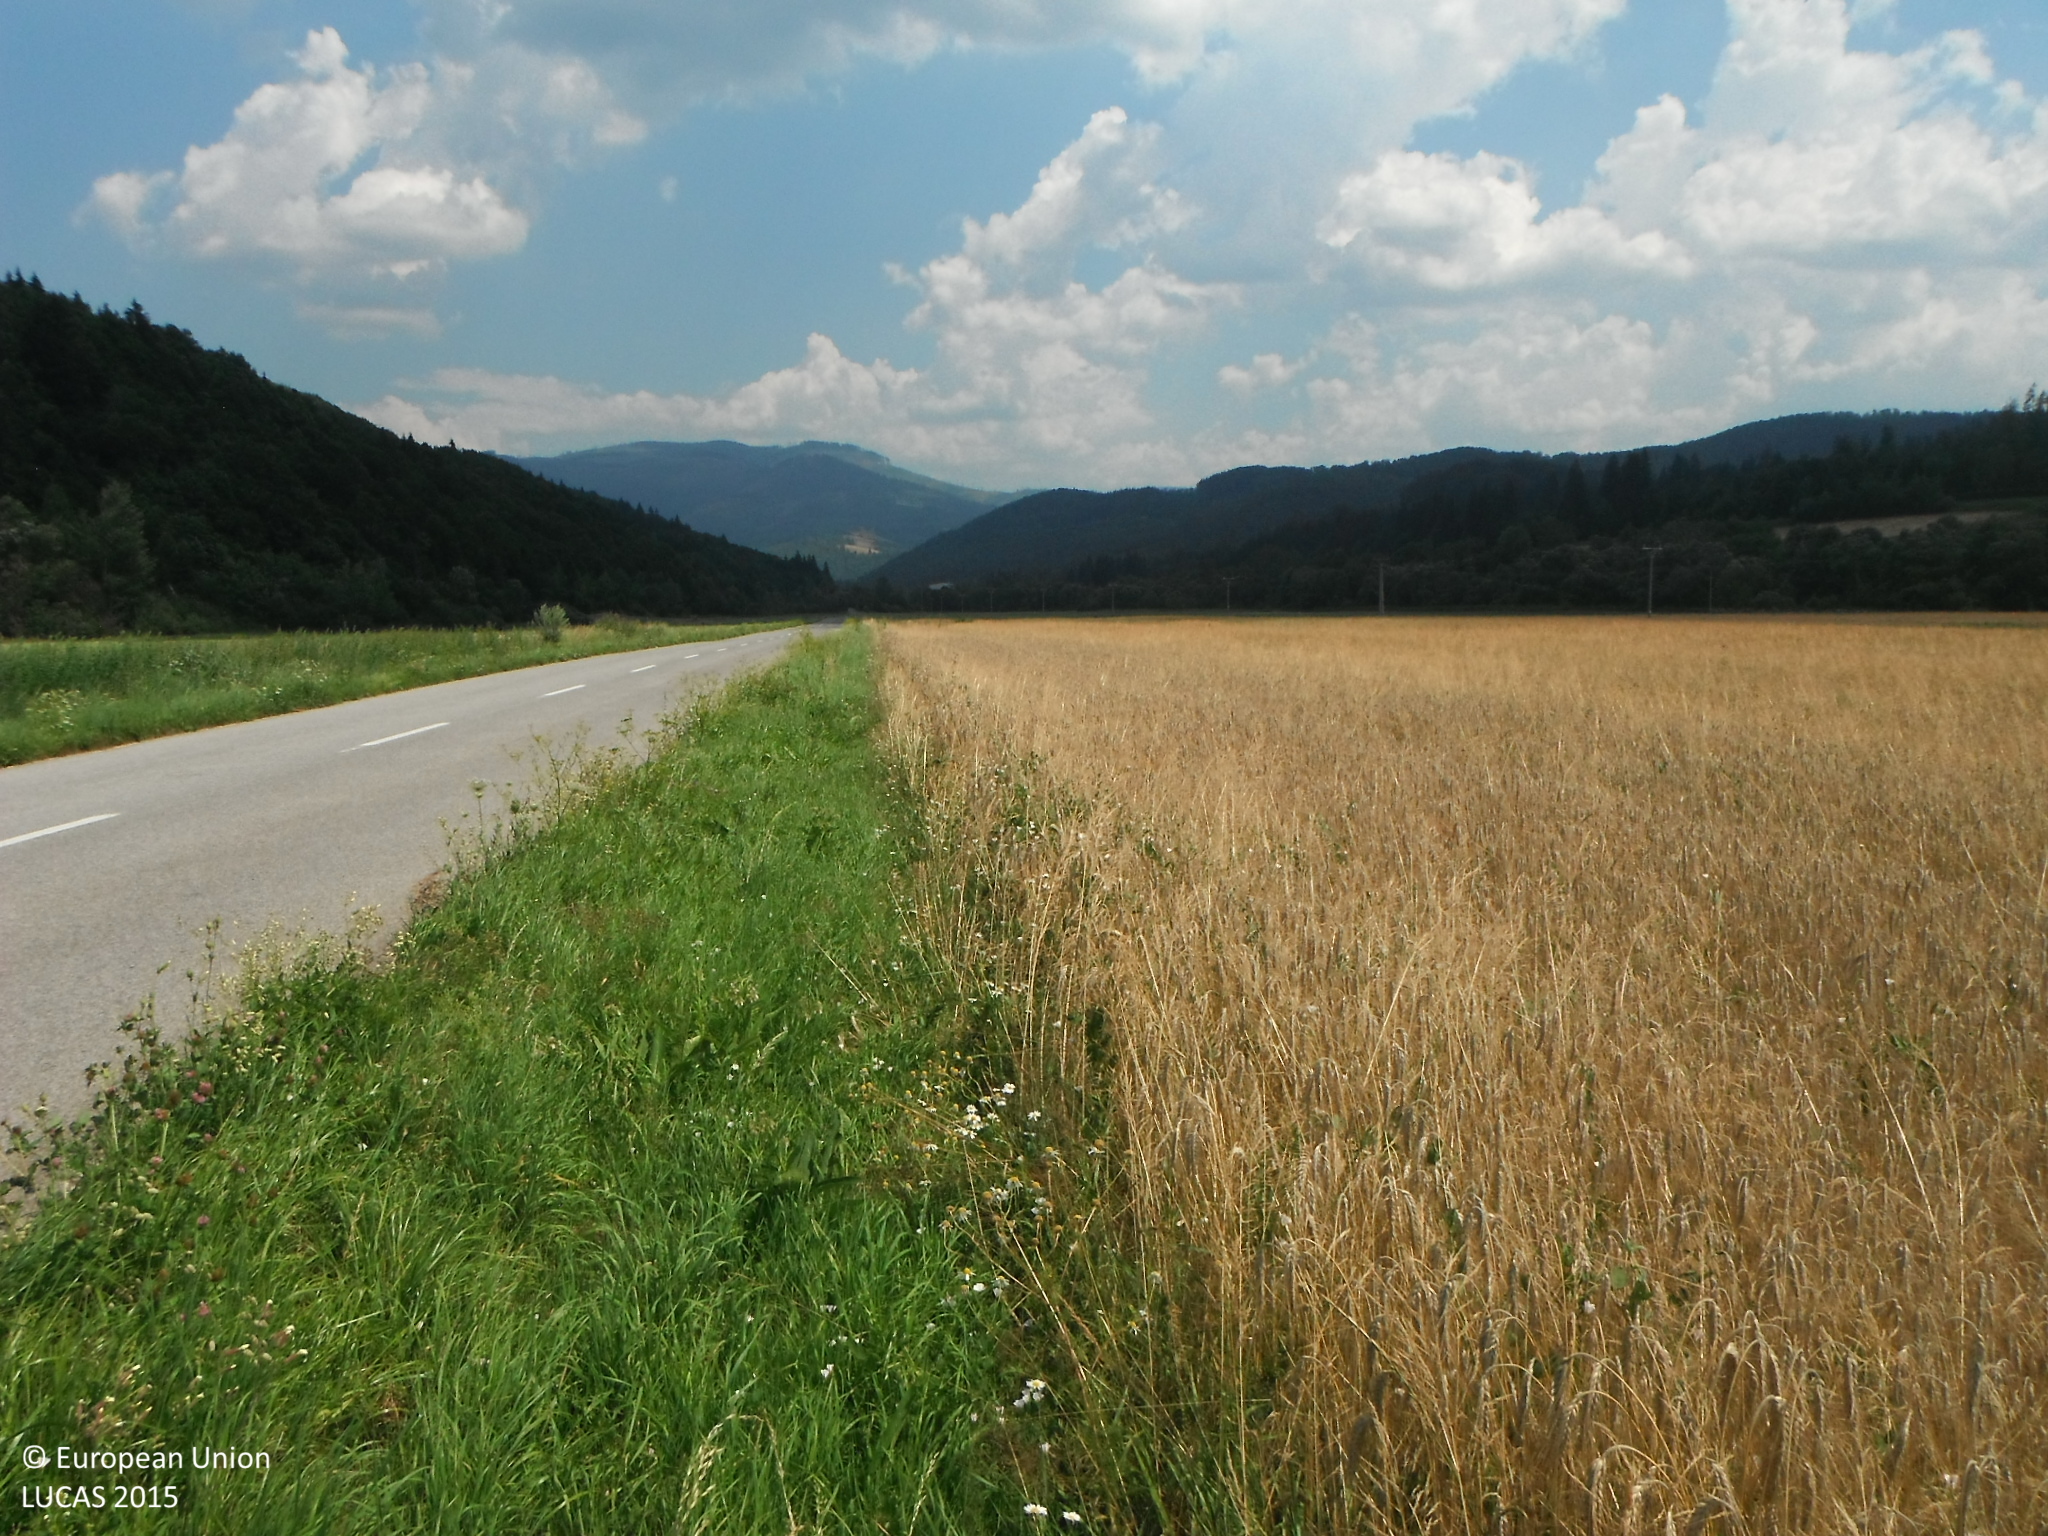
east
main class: Cropland
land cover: Common wheat
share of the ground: > 75 %
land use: Agriculture (excluding fallow land and kitchen gardens)
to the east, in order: Common wheat; Electric lines; Common wheat
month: August
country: SK
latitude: 48.7882
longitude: 20.3374
